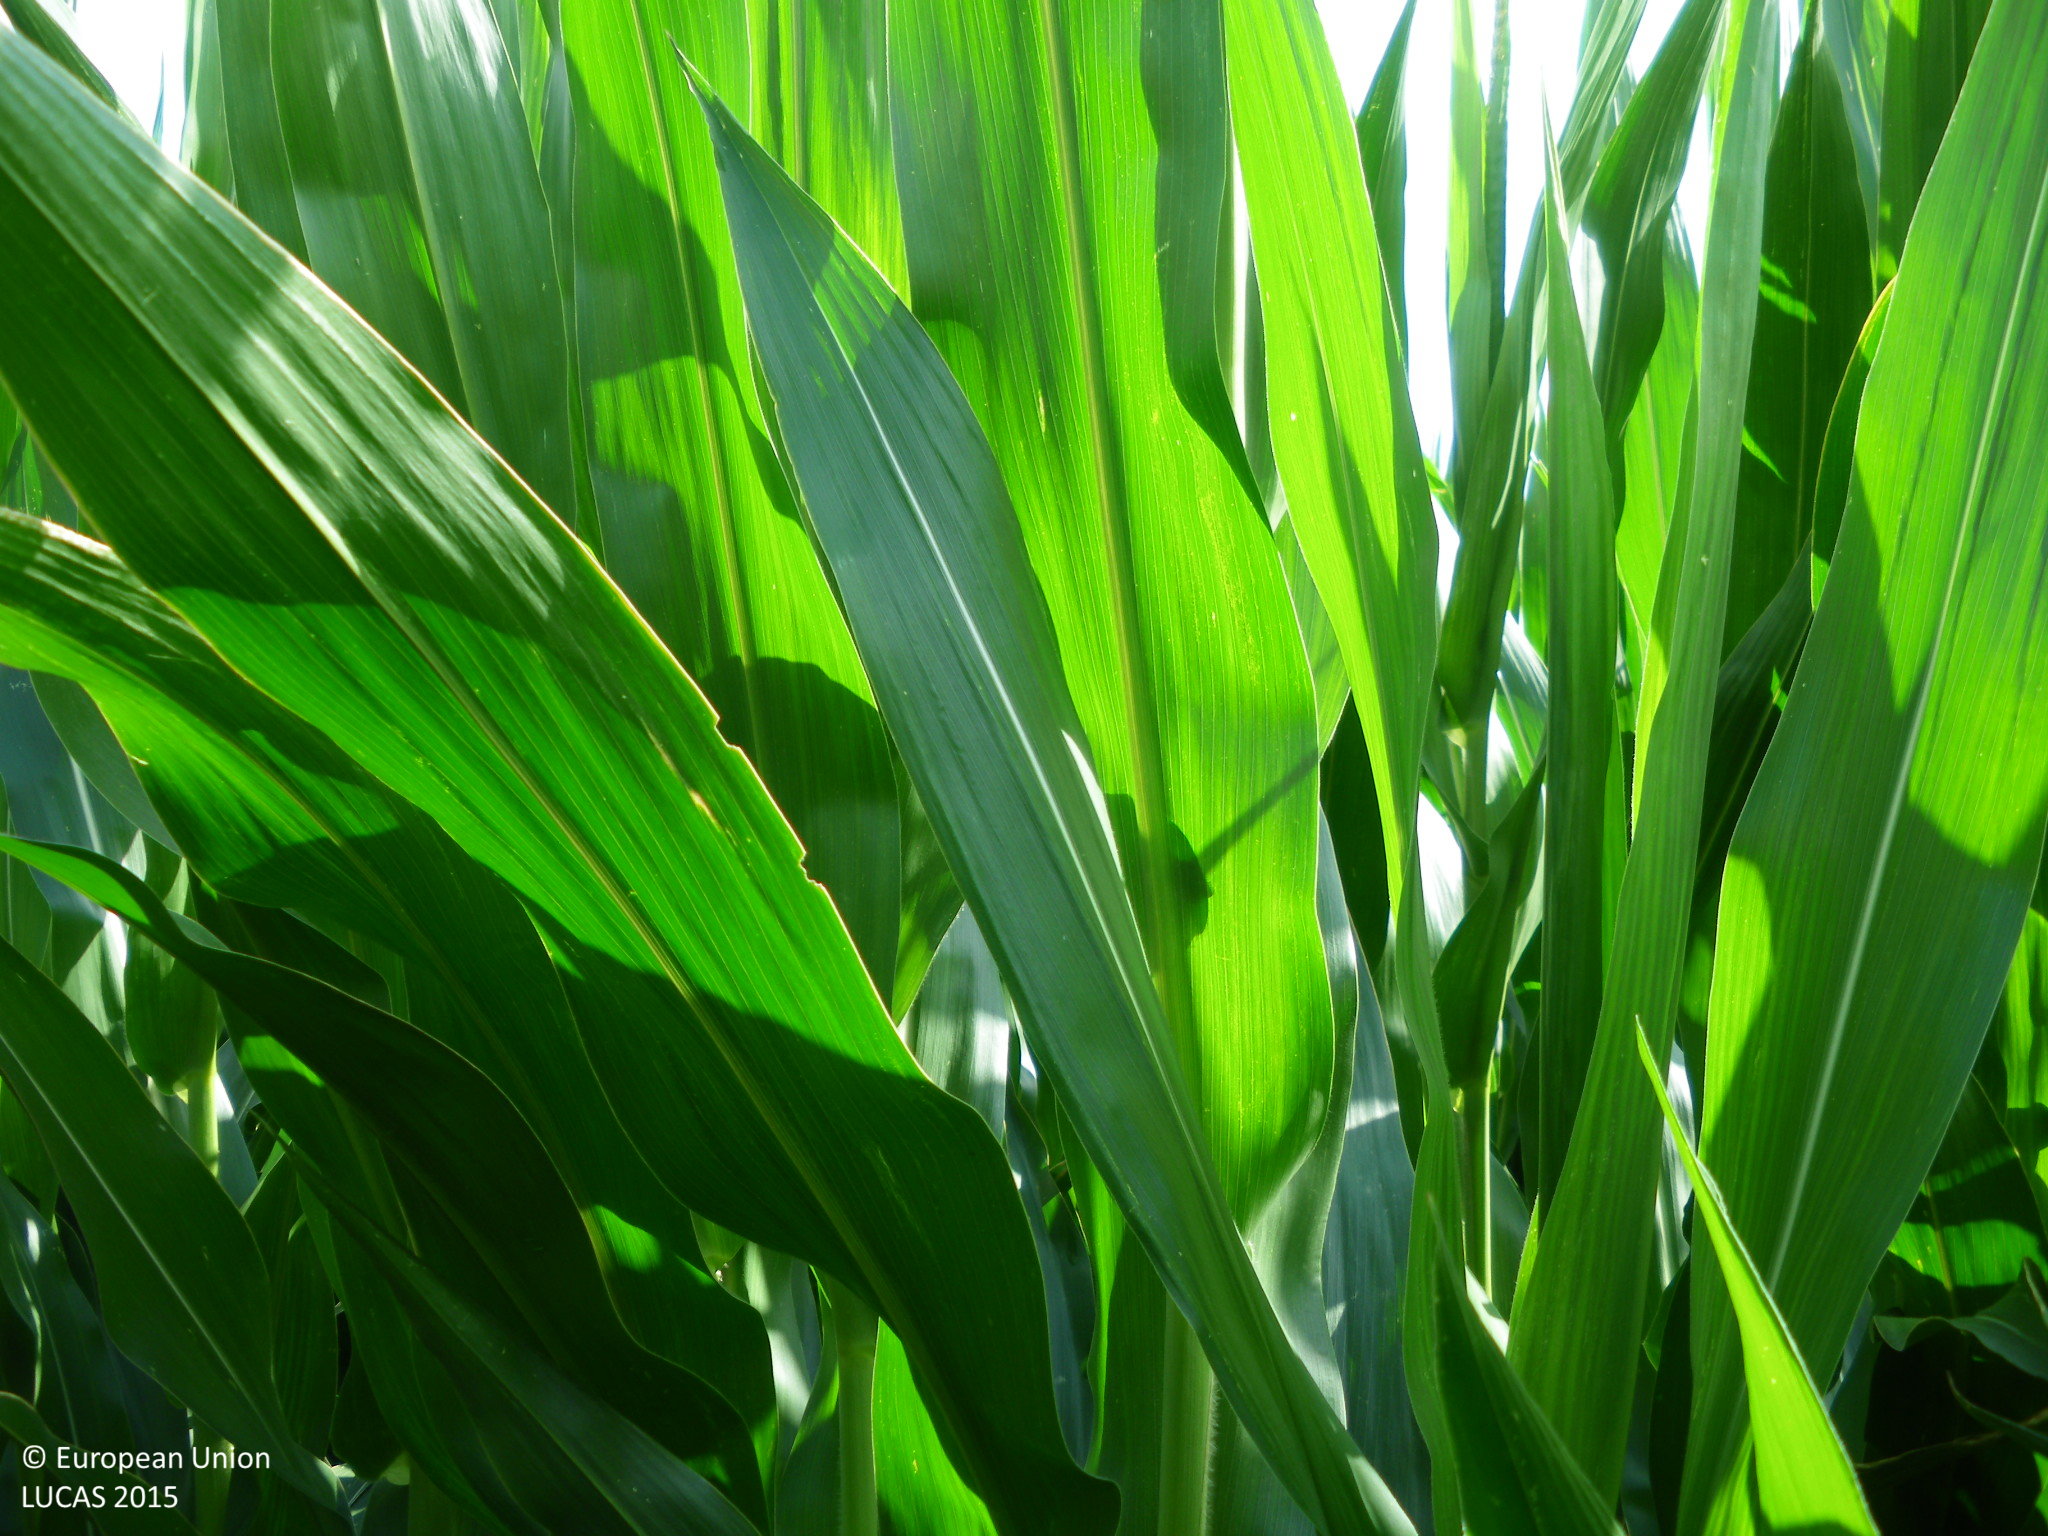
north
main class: Cropland
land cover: Maize
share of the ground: > 75 %
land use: Agriculture (excluding fallow land and kitchen gardens)
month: June
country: ES
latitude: 36.2953
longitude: -5.8678
